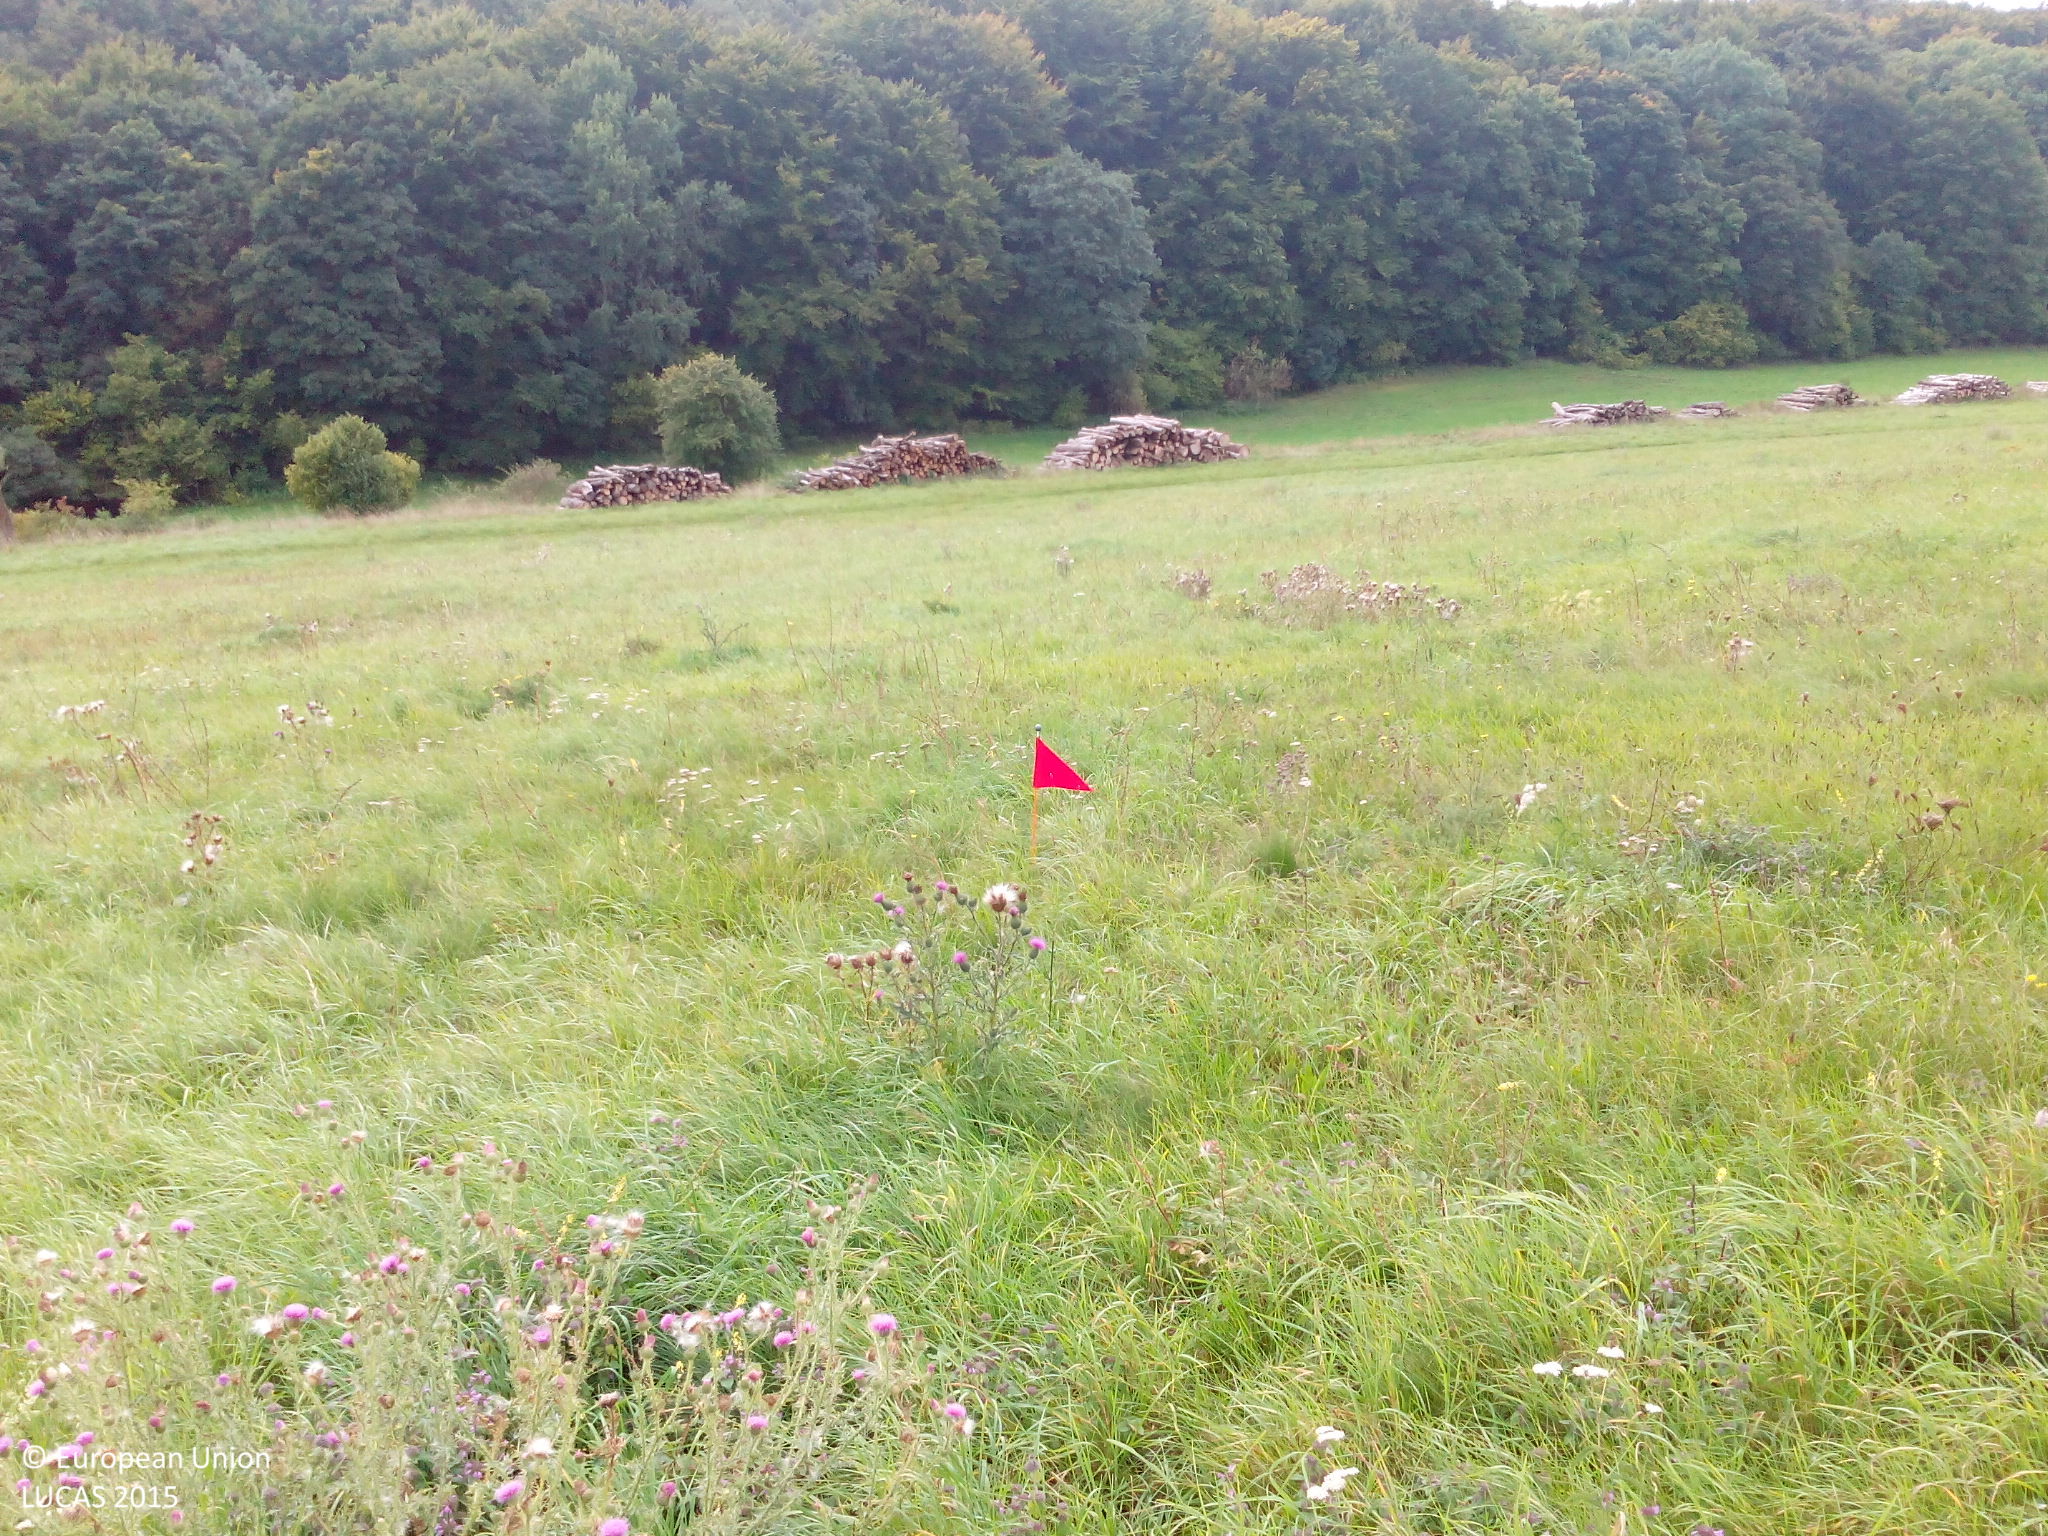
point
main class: Grassland
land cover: Grassland without tree/shrub cover
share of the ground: > 75 %
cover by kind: herbaceous plants 100 %
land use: Agriculture (excluding fallow land and kitchen gardens)
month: September
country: DE
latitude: 51.4922
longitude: 11.0223
